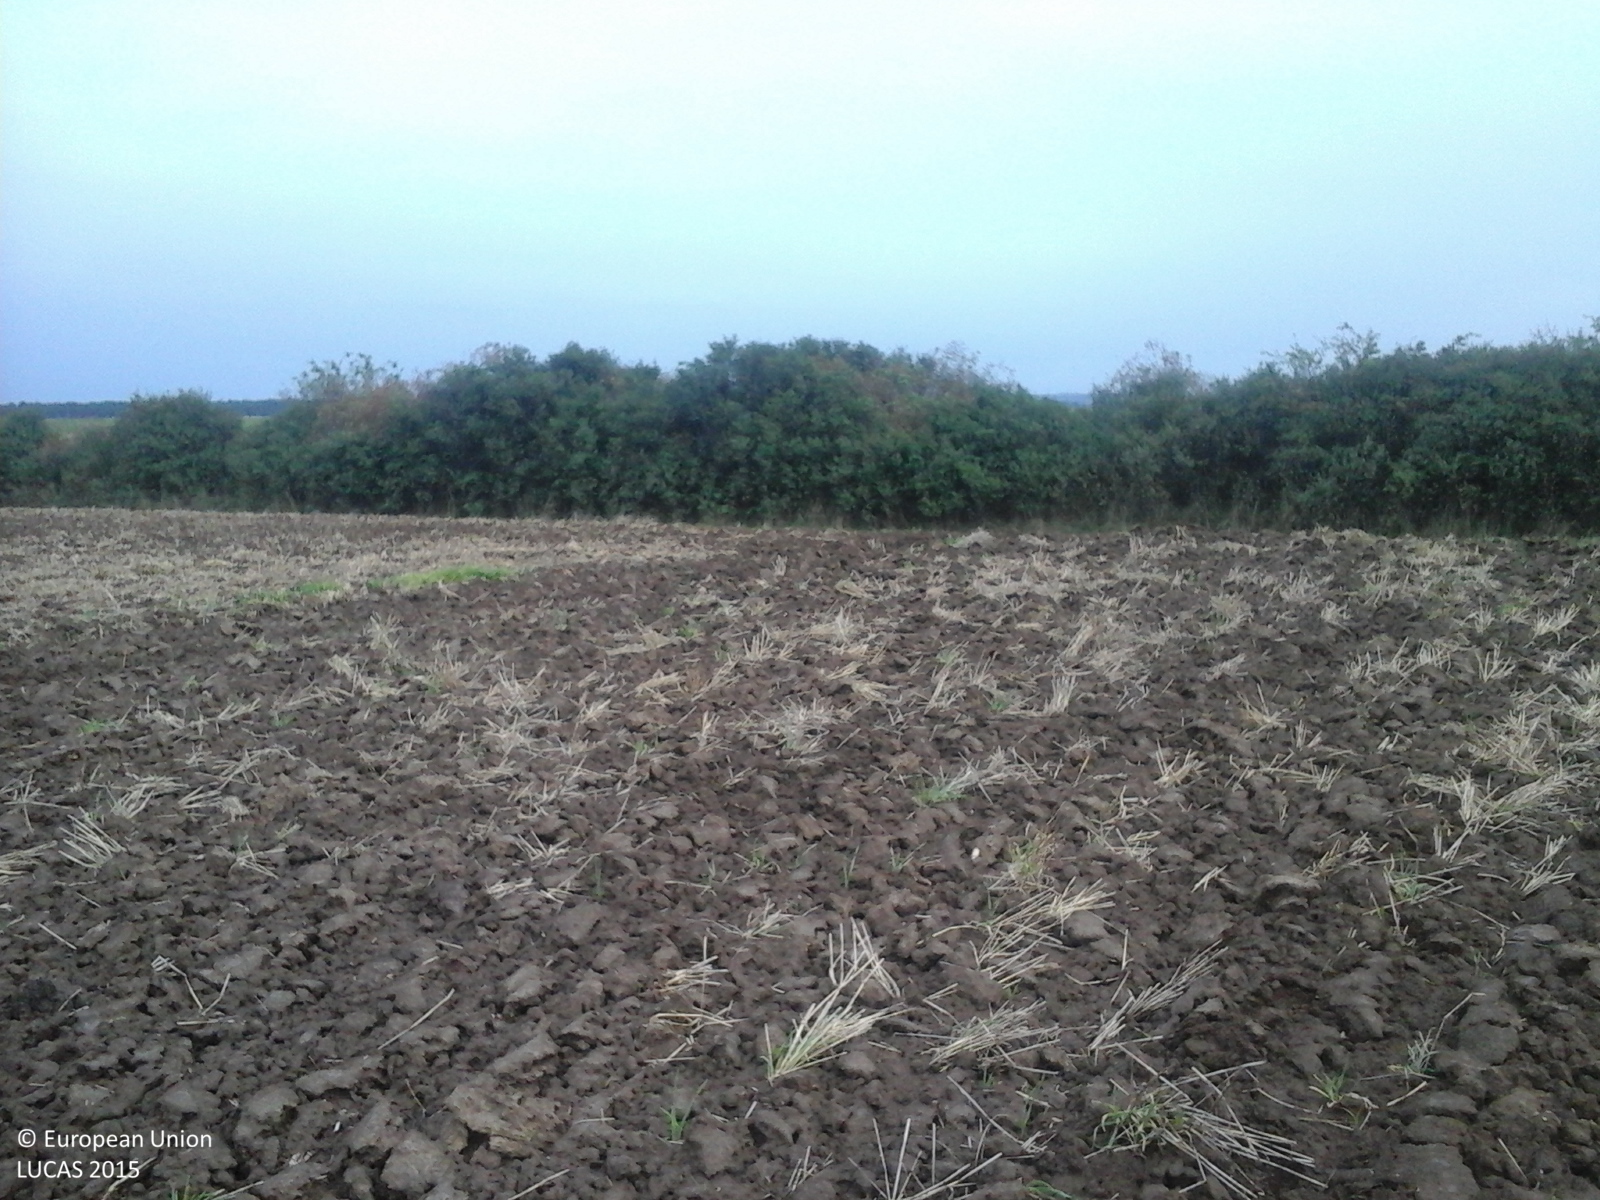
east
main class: Cropland
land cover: Common wheat
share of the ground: < 10 %
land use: Agriculture (excluding fallow land and kitchen gardens)
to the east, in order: Common wheat; Tracks; Shrubland without tree cover; Maize; Tracks; Spontaneously vegetated surfaces; Barley; Spontaneously vegetated surfaces; Common wheat
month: September
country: RO
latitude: 47.1637
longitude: 22.0127
